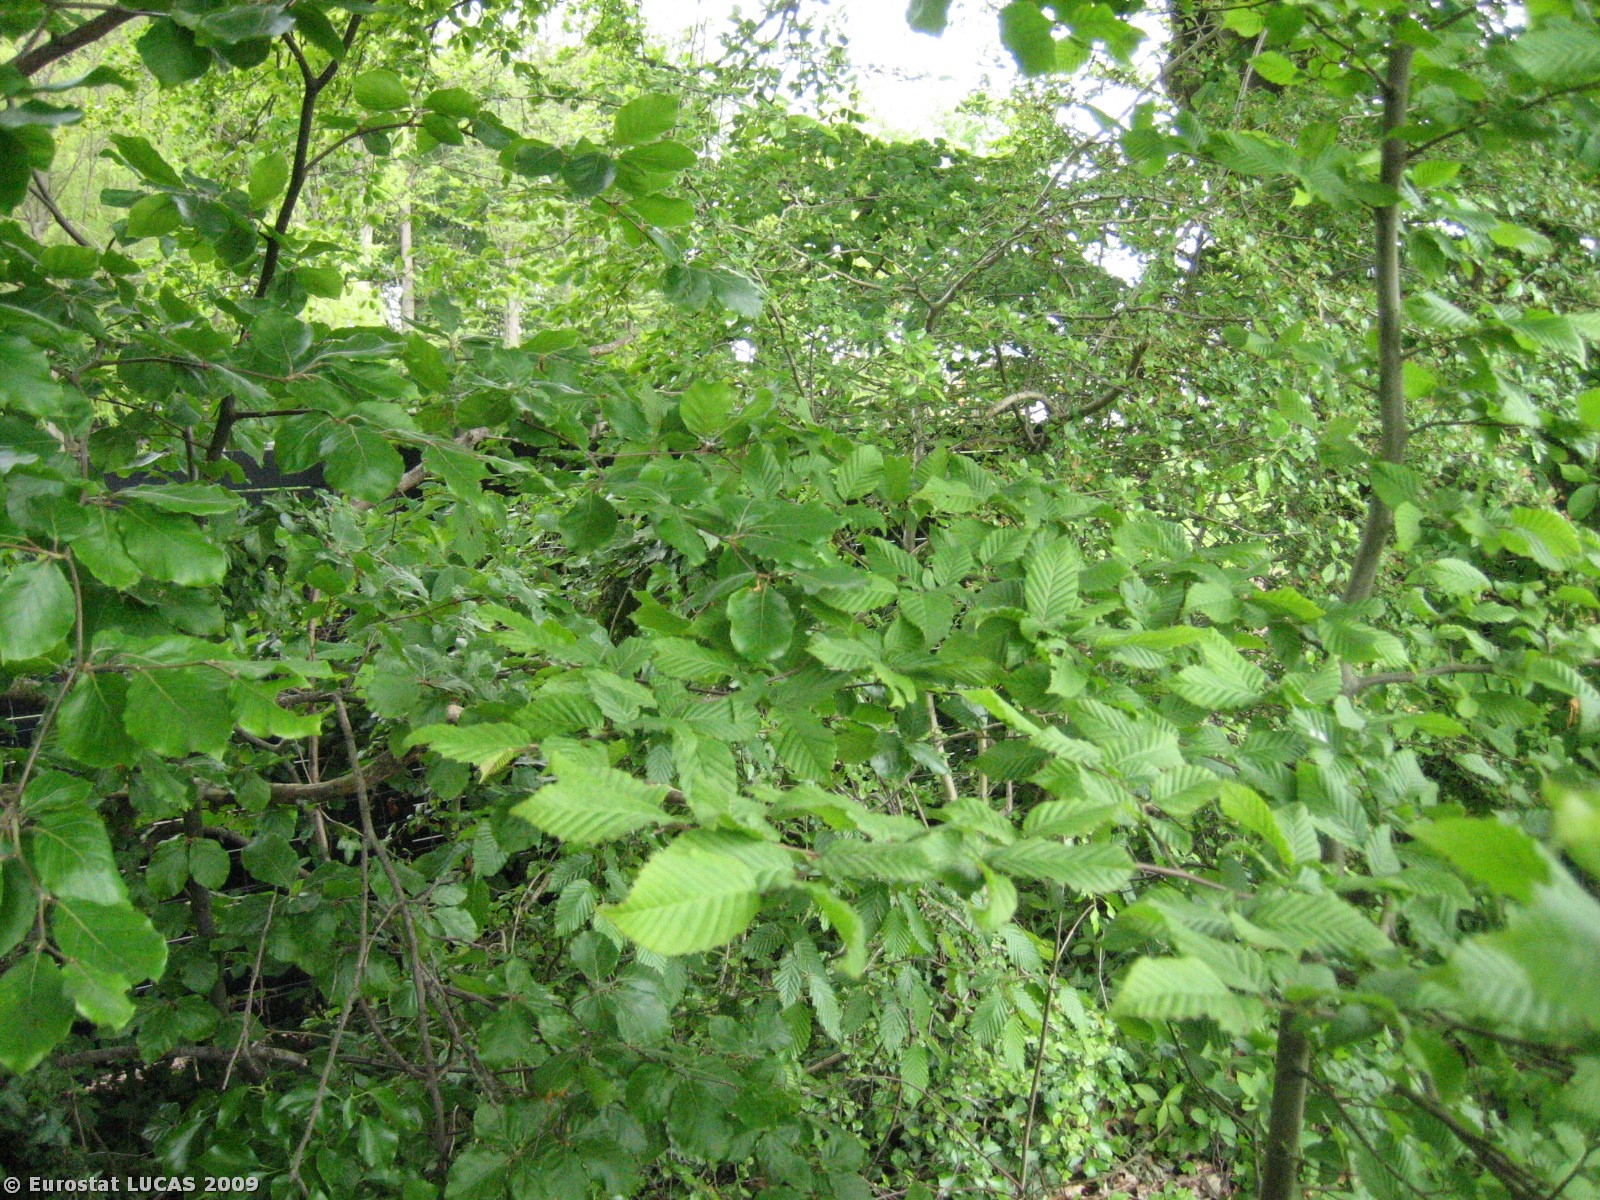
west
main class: Woodland
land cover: Broadleaved woodland
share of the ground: > 75 %
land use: Unused
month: June
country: DK
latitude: 56.2414
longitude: 10.2740
